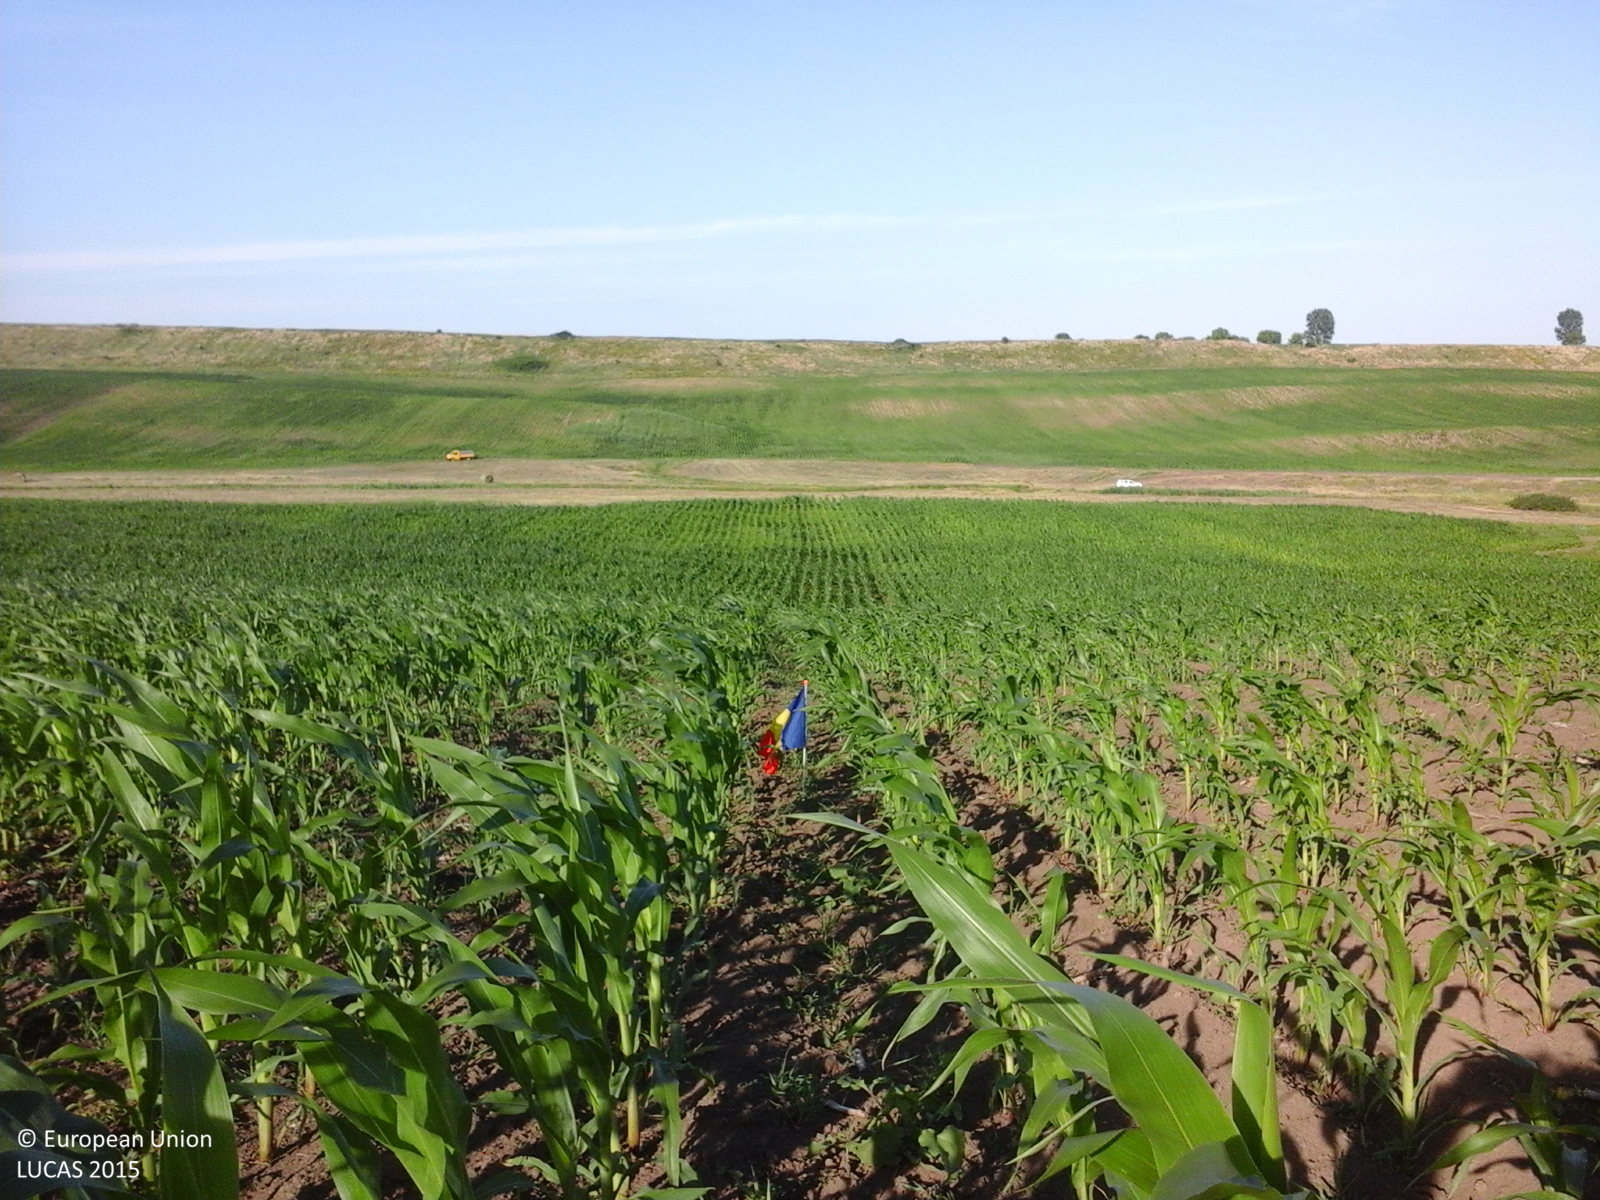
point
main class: Cropland
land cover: Maize
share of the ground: 25 - 50 %
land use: Agriculture (excluding fallow land and kitchen gardens)
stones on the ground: < 10 %
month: June
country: RO
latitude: 47.8374
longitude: 27.1723
